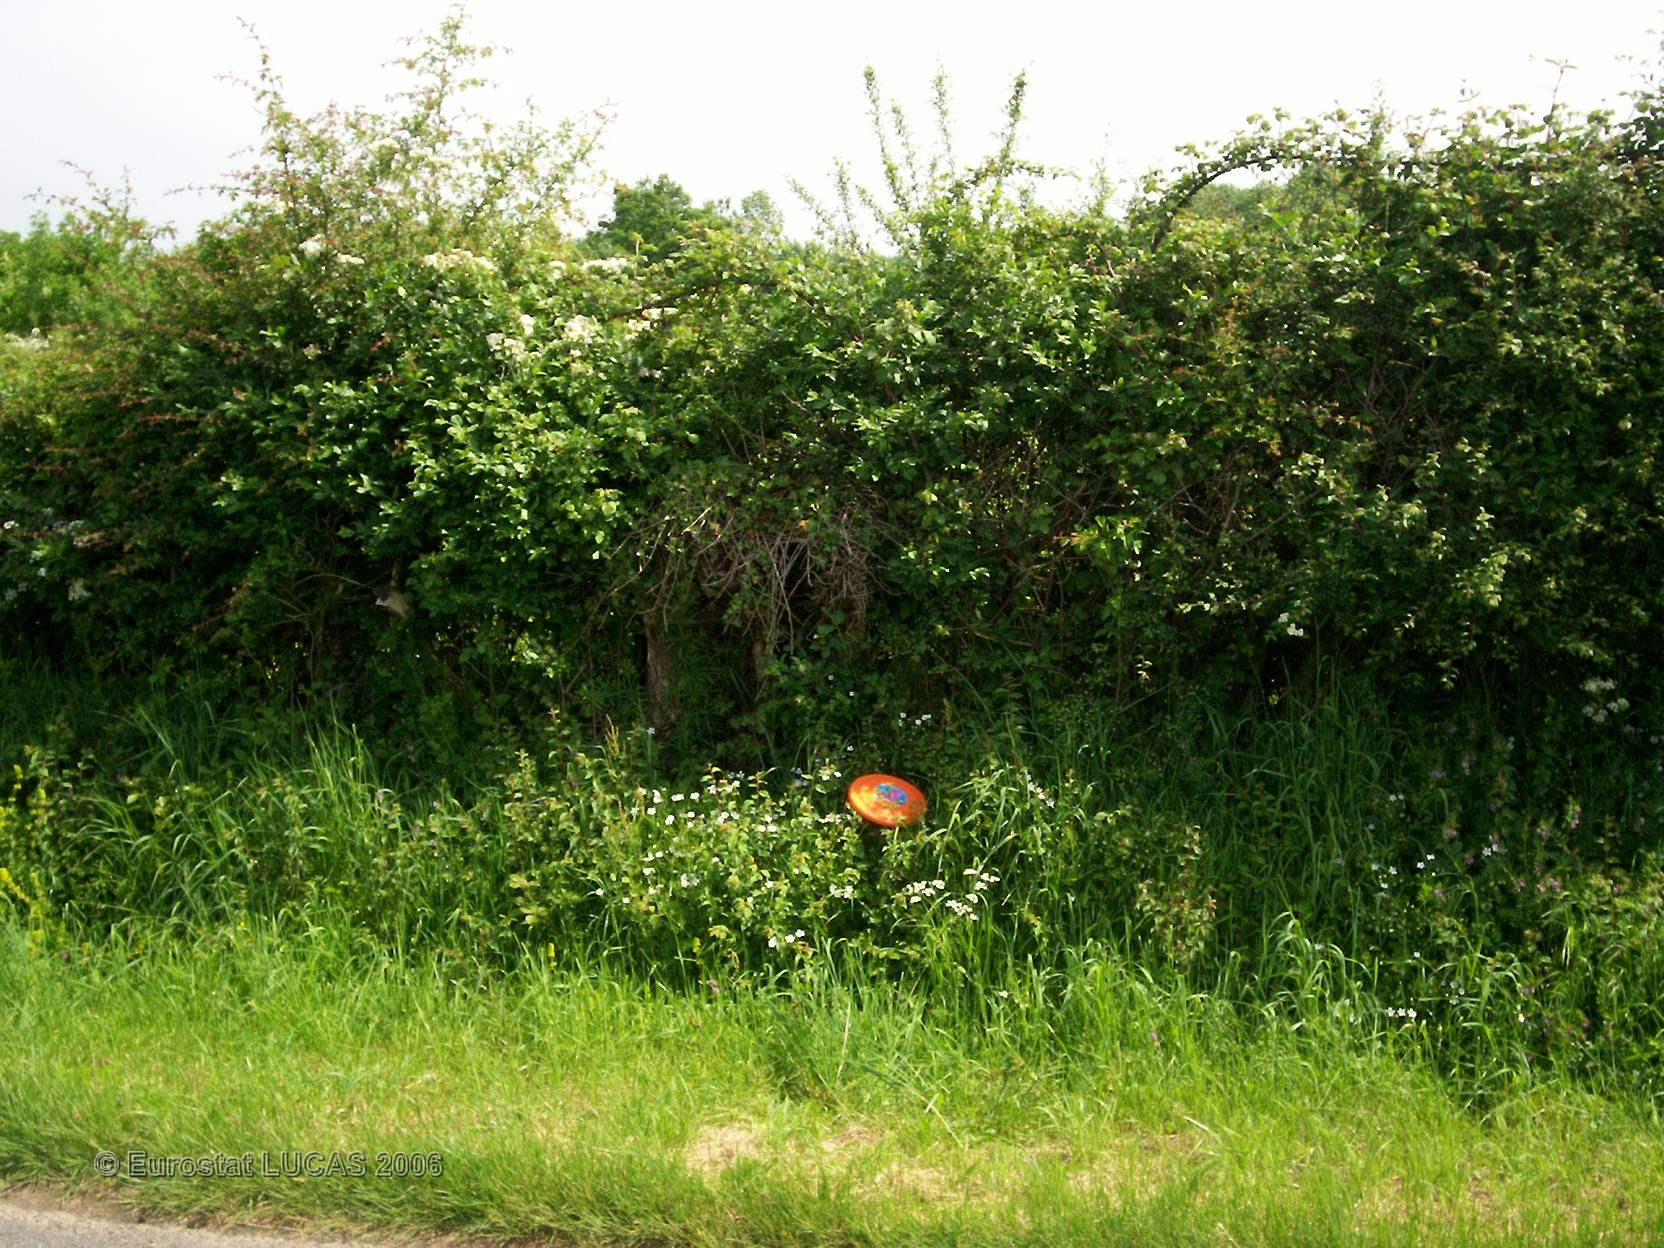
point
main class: Grassland
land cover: Grassland without tree/shrub cover
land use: Agriculture (excluding fallow land and kitchen gardens)
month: May
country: FR
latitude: 46.5232
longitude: -0.3100
